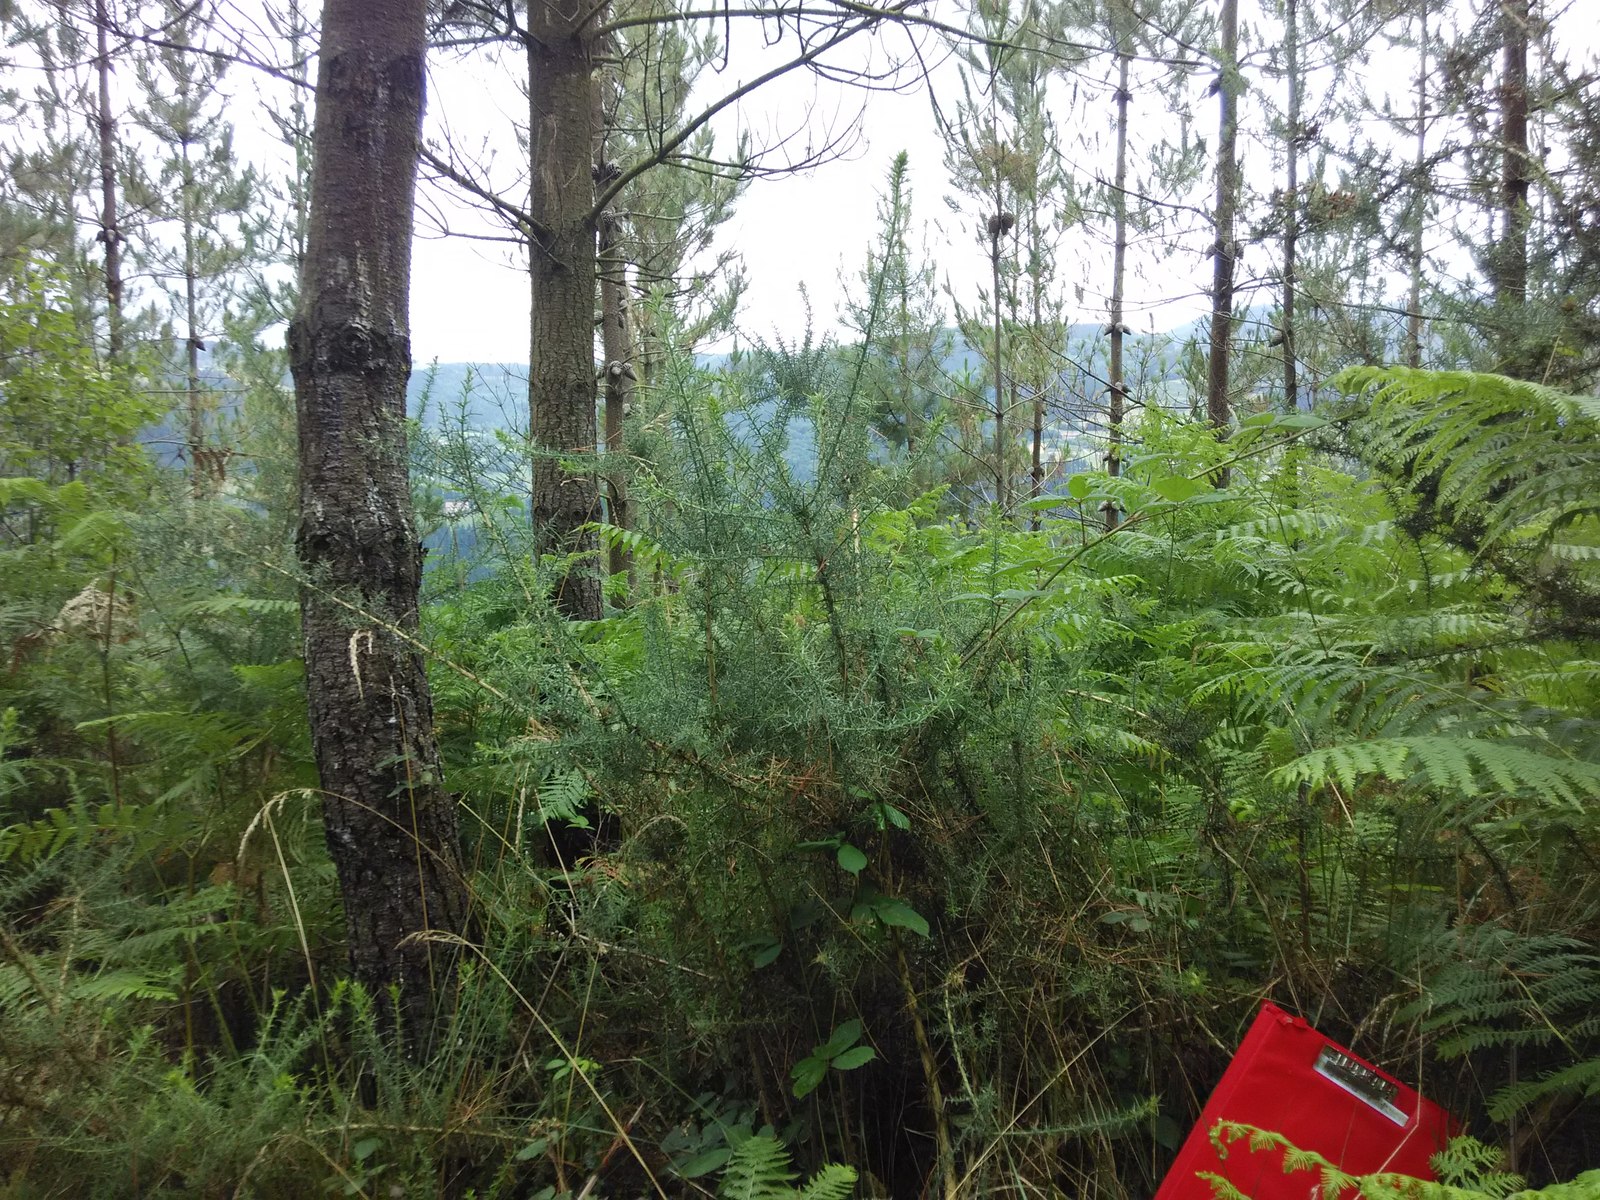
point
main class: Woodland
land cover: Pine dominated coniferous woodland
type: exotic forest
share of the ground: > 75 %
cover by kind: coniferous forest trees 90 %, unconsolidated bare surface 10 %
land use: Forestry
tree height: > 5 m
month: July
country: ES
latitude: 43.0934
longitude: -2.3969
